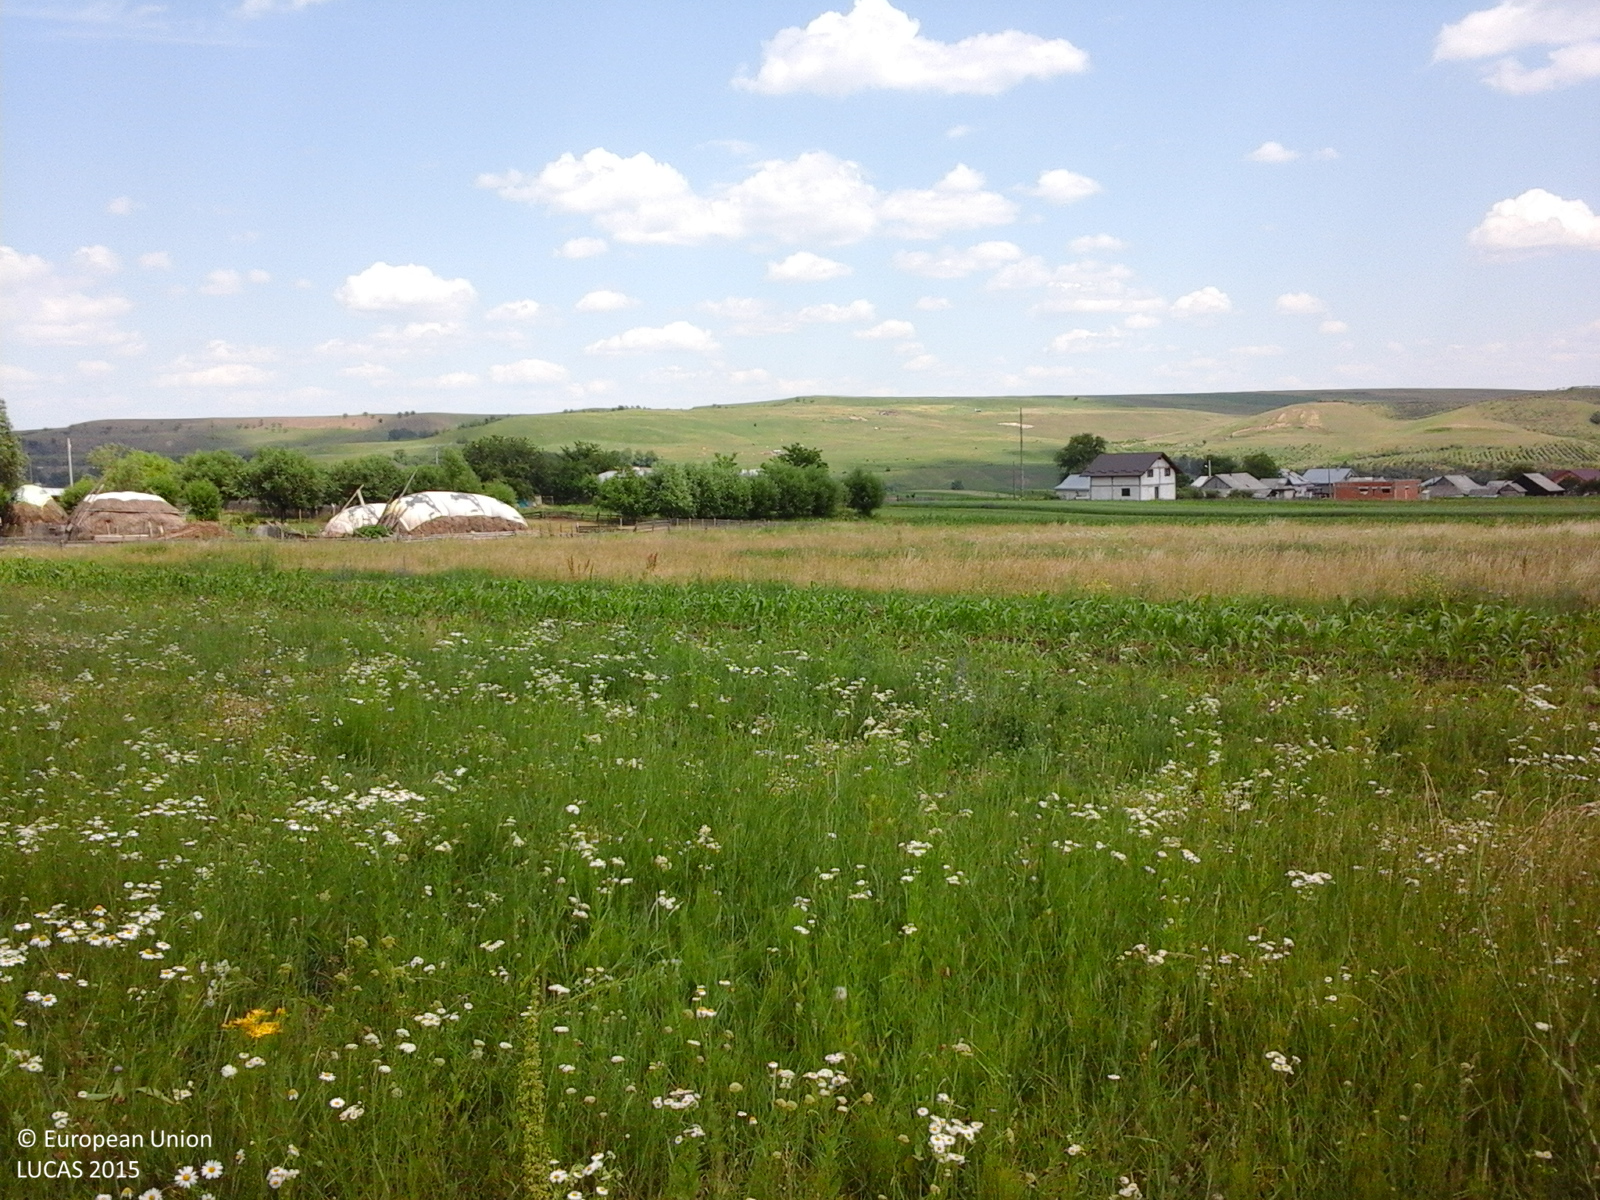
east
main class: Cropland
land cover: Apple fruit
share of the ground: 50 - 75 %
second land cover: Grassland without tree/shrub cover
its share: > 75 %
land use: Agriculture (excluding fallow land and kitchen gardens)
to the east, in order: Apple fruit; Grassland without tree/shrub cover; Fences; Grassland without tree/shrub cover; Maize; Grassland without tree/shrub cover; Tracks; Grassland without tree/shrub cover; Fences; Grassland without tree/shrub cover; Fences; Maize; Lines of trees; Lucerne; Artificial constructions in urban areas; Other fresh vegetables; Maize
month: June
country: RO
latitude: 47.5179
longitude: 26.2707
